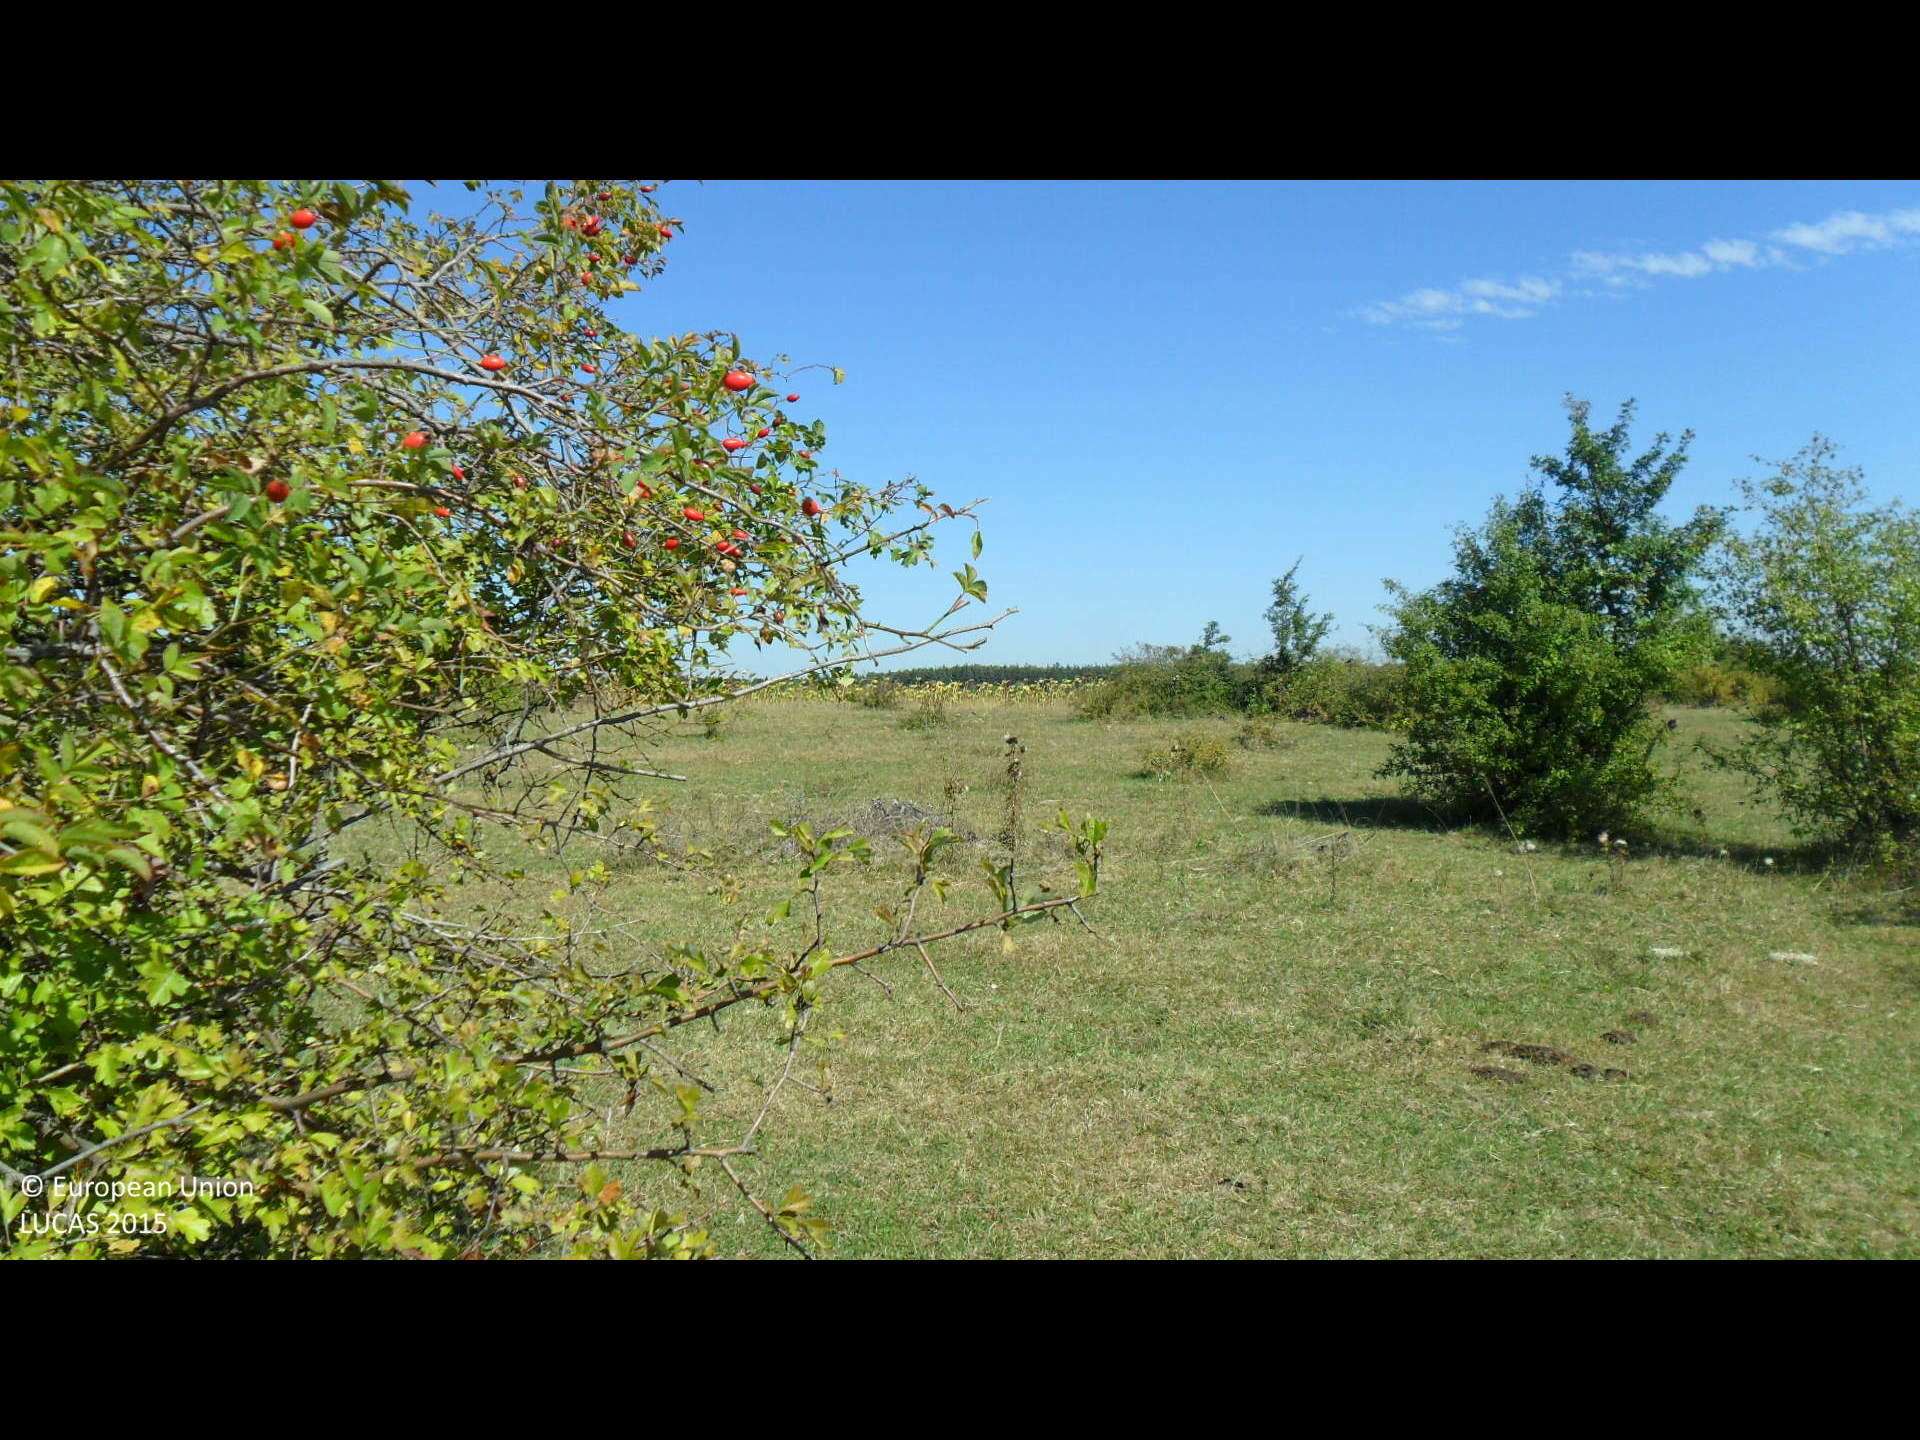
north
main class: Grassland
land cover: Grassland with sparse tree/shrub cover
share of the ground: > 75 %
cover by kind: herbaceous plants 90 %, broadleaved forest trees 5 %, shrubs 5 %
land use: Agriculture (excluding fallow land and kitchen gardens)
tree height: < 5 m
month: September
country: BG
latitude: 43.1057
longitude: 26.5294
